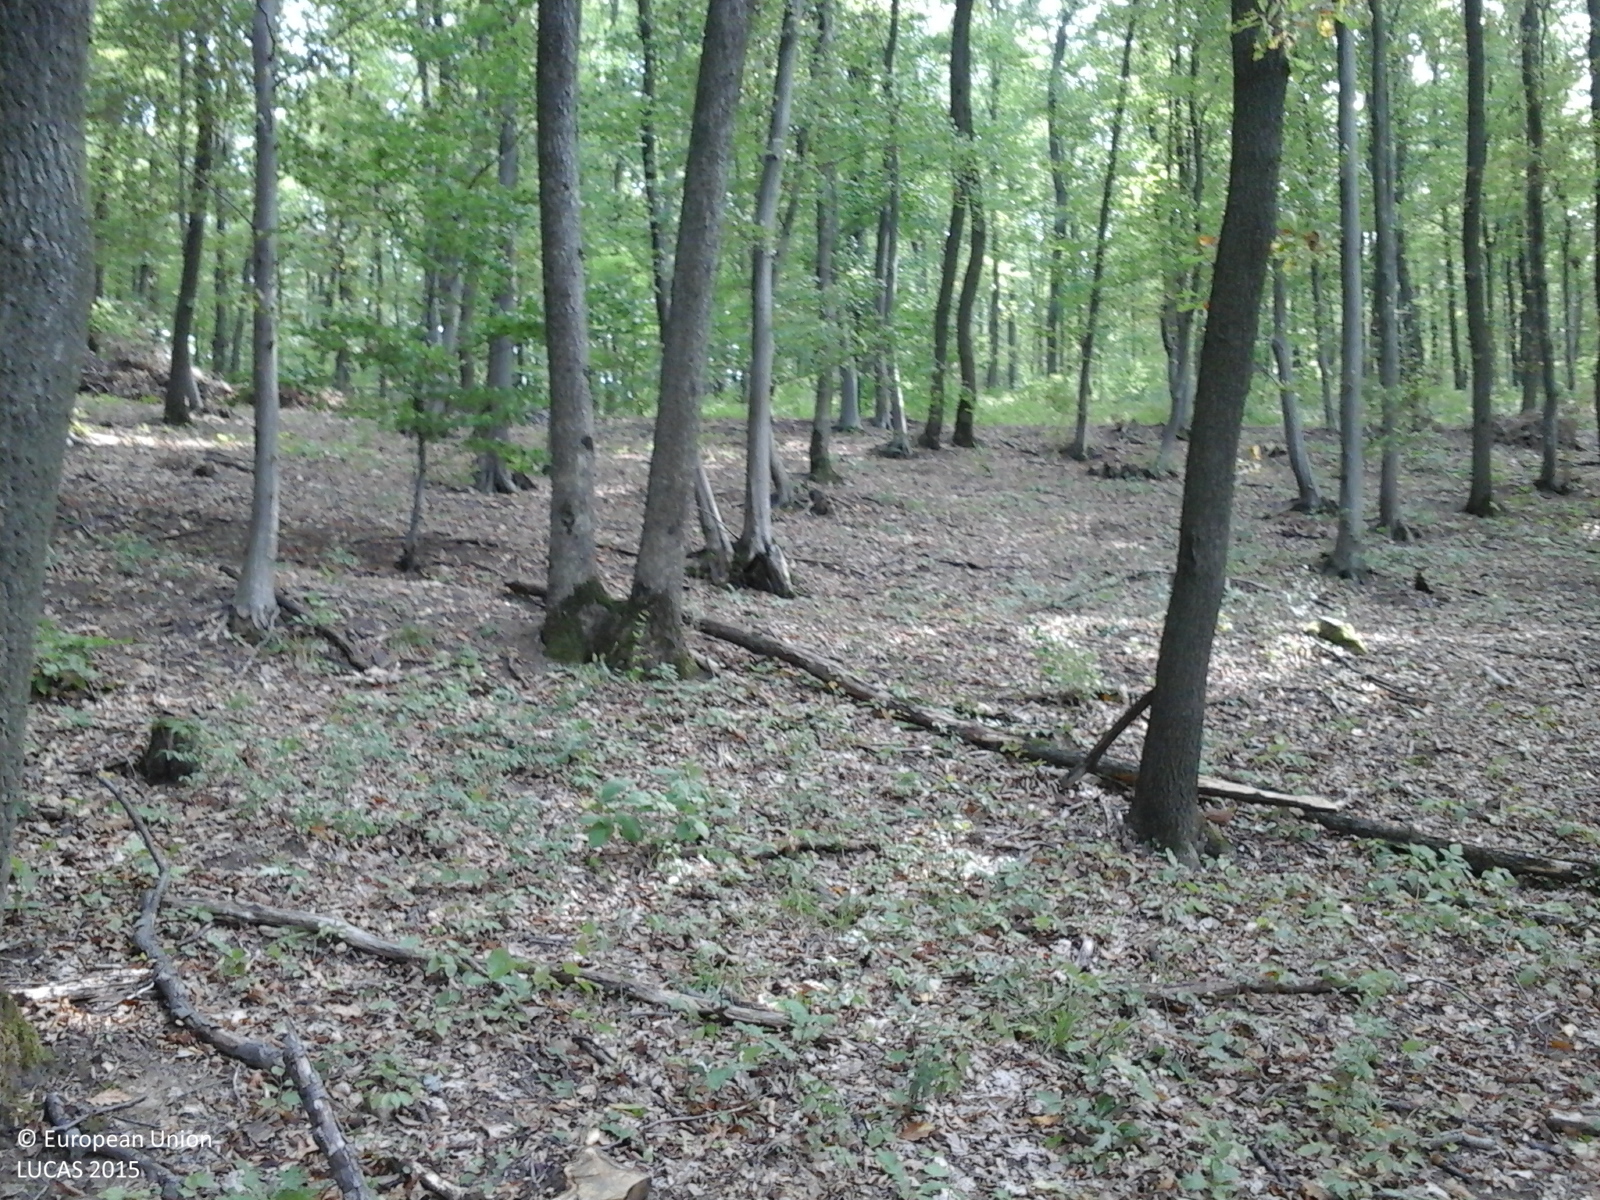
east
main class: Woodland
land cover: Broadleaved woodland
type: acidophilous oak and oak-birch forest
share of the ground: > 75 %
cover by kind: broadleaved forest trees 100 %
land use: Forestry
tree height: > 5 m
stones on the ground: < 10 %
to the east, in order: Broadleaved woodland; Tracks; Broadleaved woodland; Tracks; Broadleaved woodland; Other mixed woodland
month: September
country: RO
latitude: 45.9387
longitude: 22.8353
